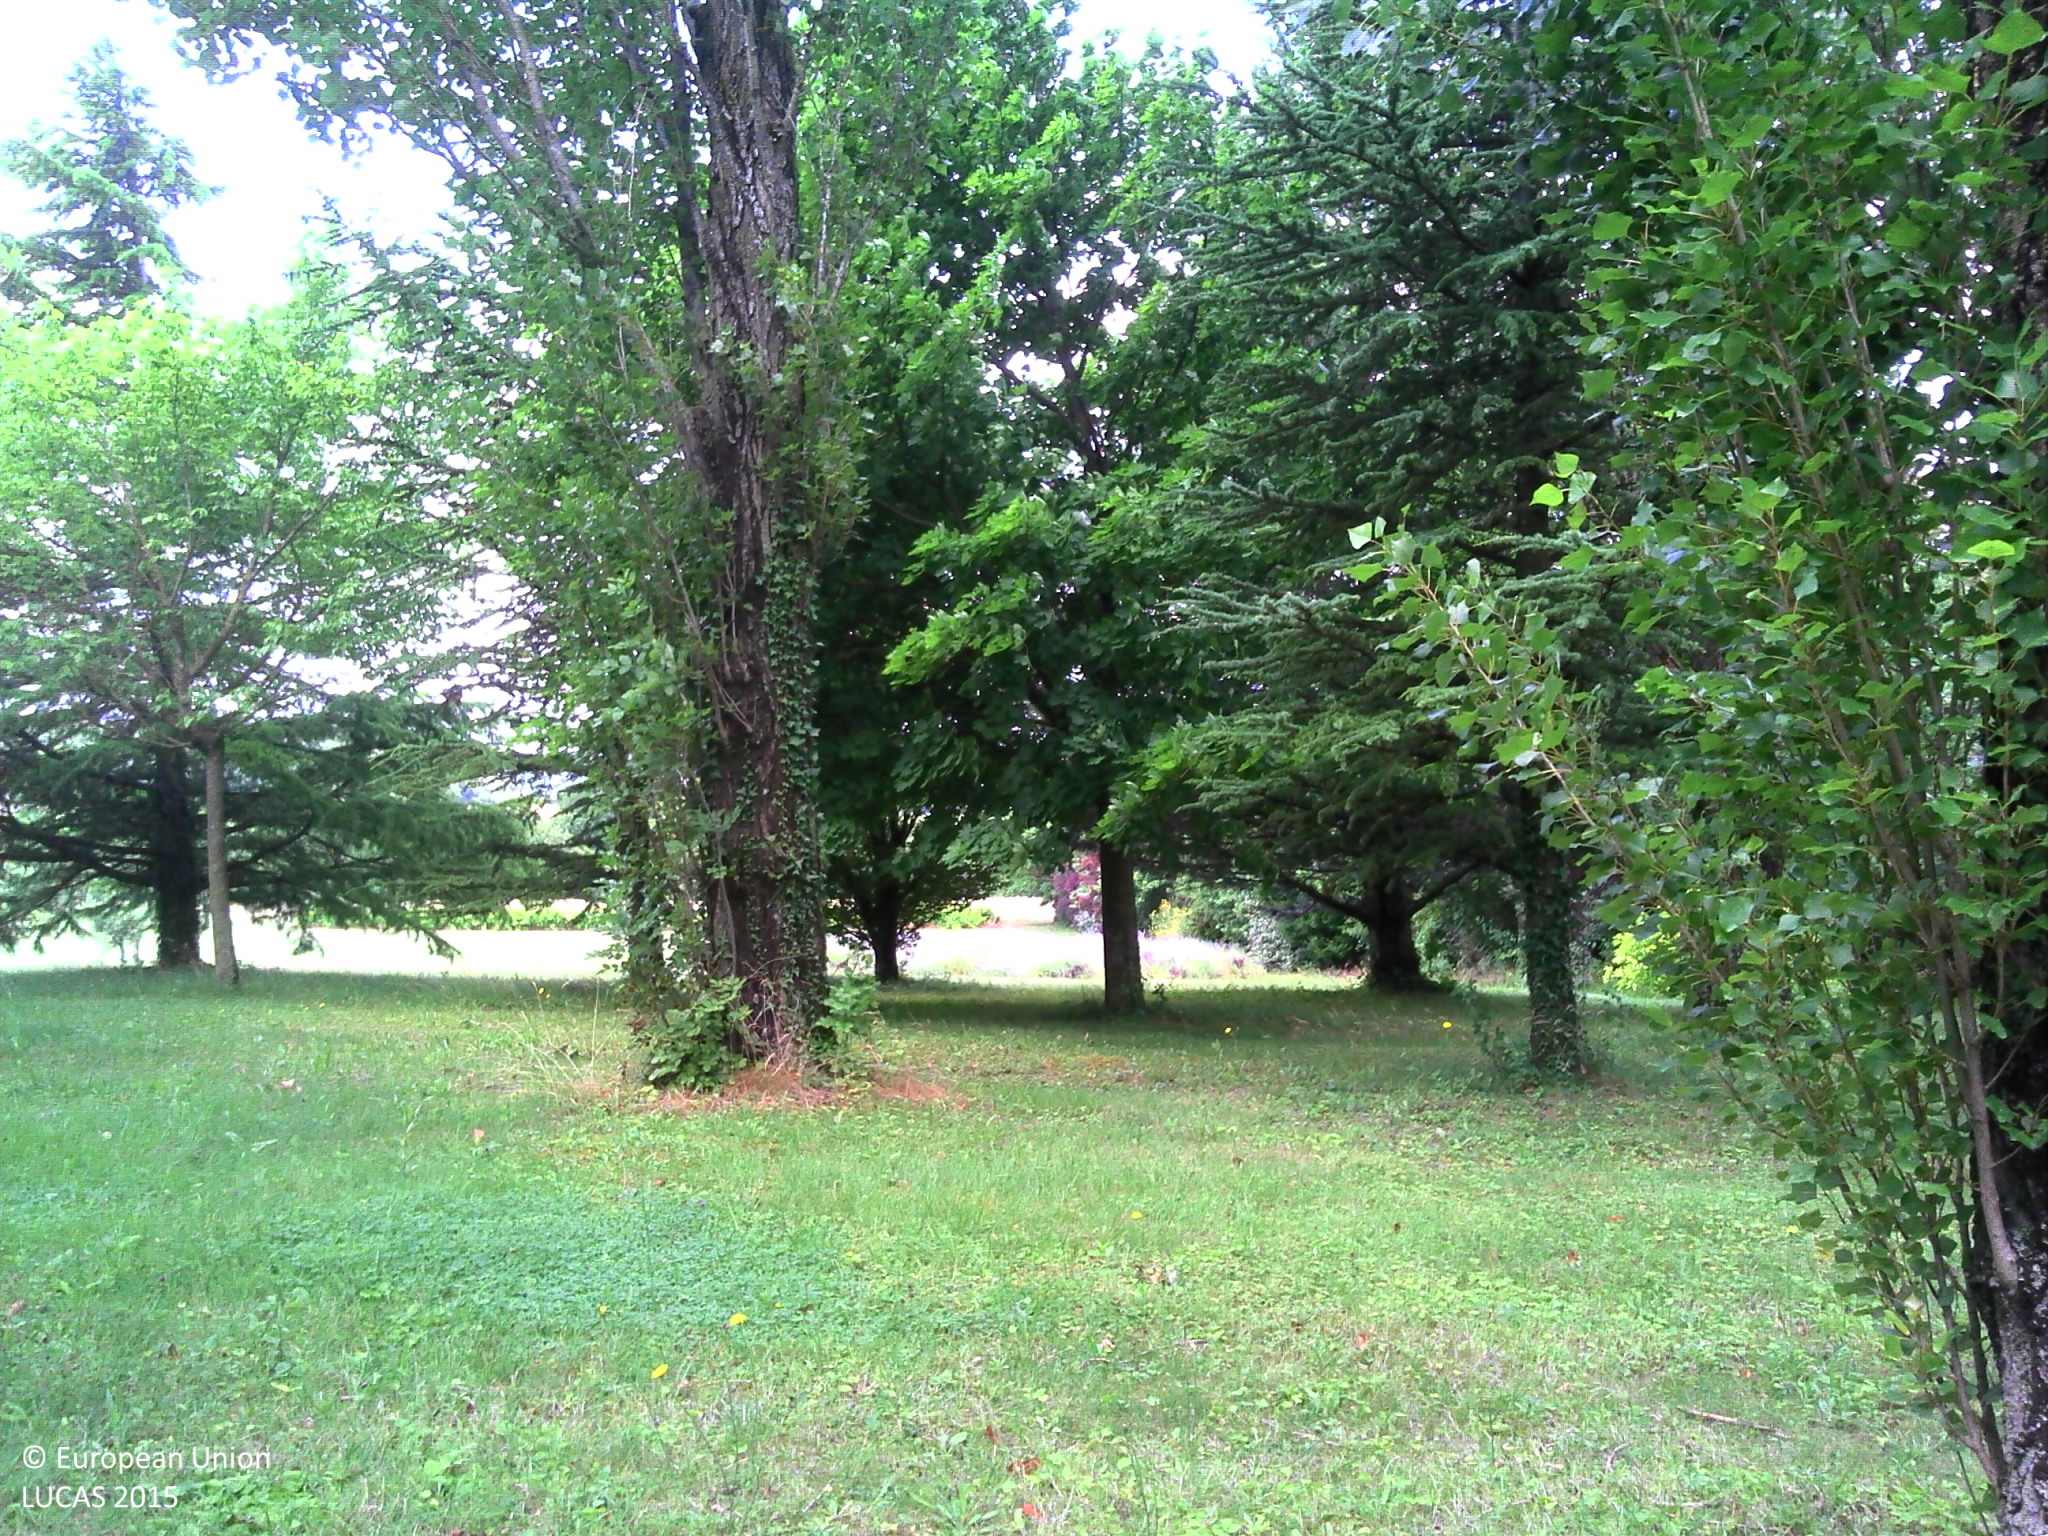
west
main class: Grassland
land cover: Grassland with sparse tree/shrub cover
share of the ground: > 75 %
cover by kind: herbaceous plants 95 %, broadleaved forest trees 5 %
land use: Residential
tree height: > 5 m
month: June
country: FR
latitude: 44.7919
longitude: 5.0386
